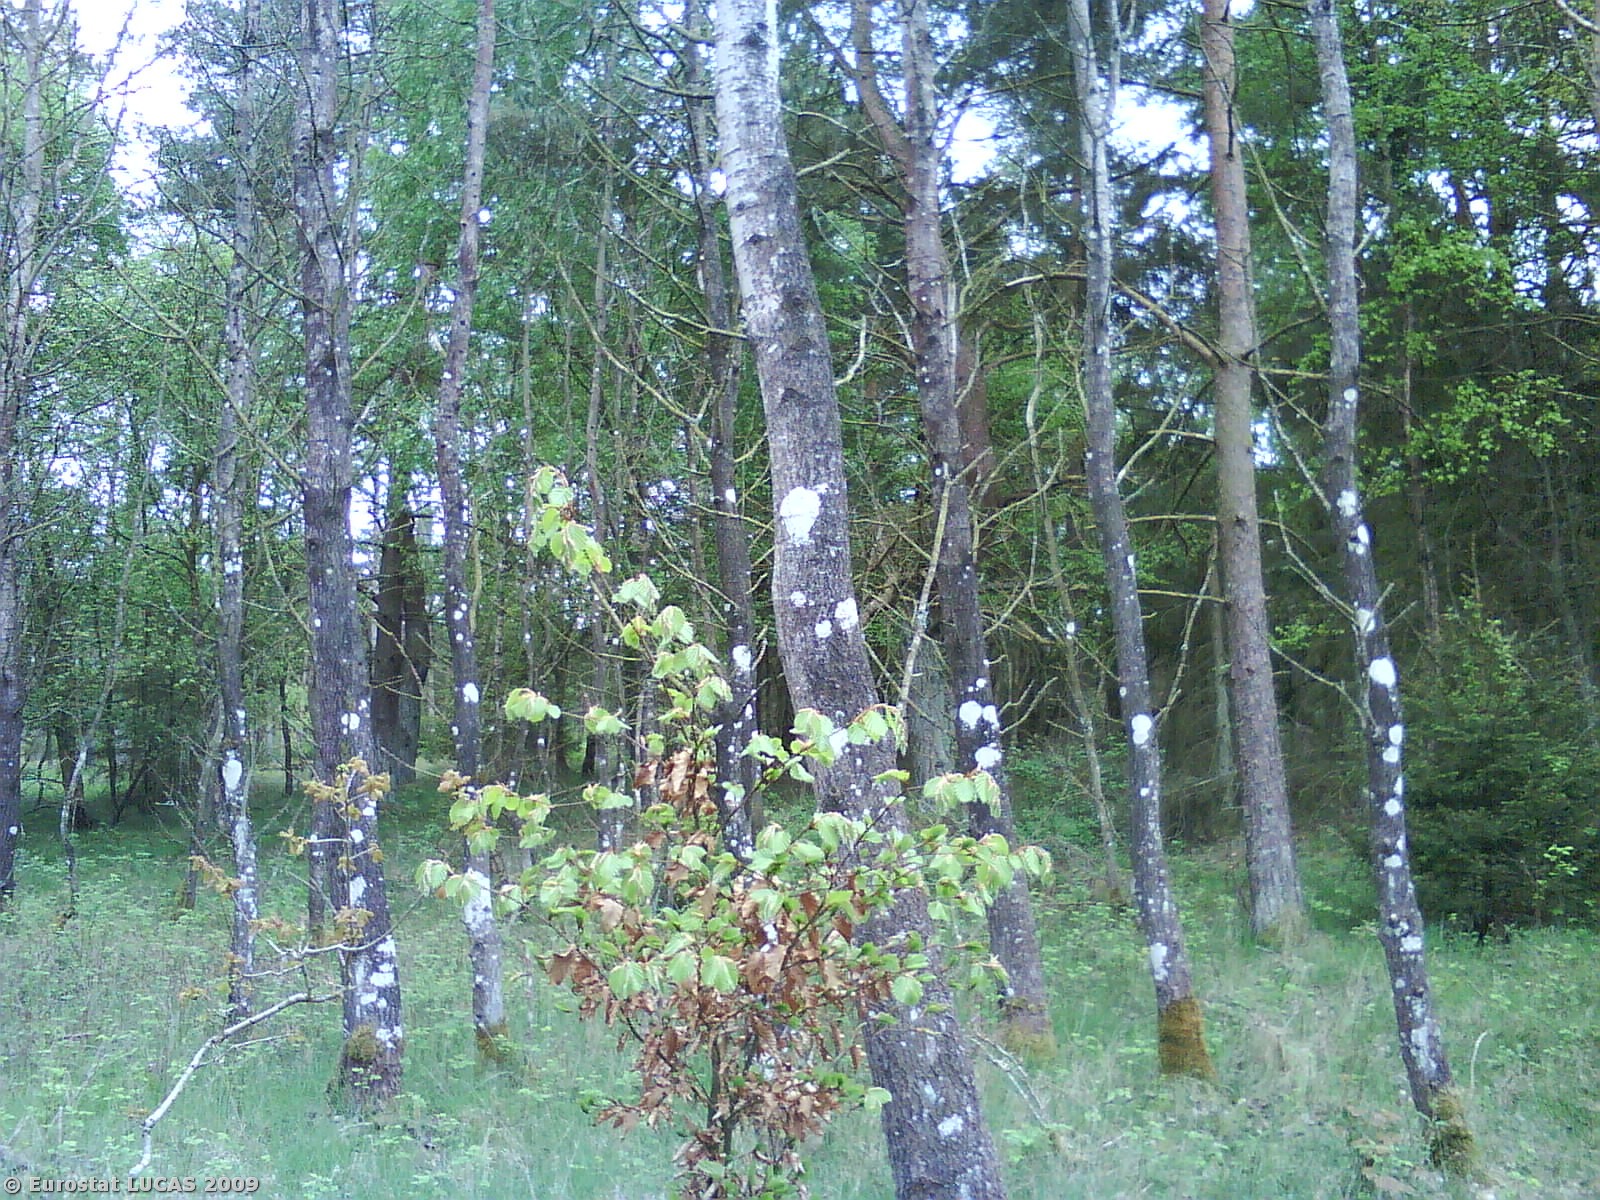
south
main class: Woodland
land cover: Mixed woodland
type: hemiboreal forest and nemoral coniferous forest and mixed broadleaved-coniferous forest
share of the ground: 10 - 25 %
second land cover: Grassland with sparse tree/shrub cover
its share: > 75 %
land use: Forestry
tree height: > 5 m
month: May
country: DK
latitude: 56.4913
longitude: 10.7299
